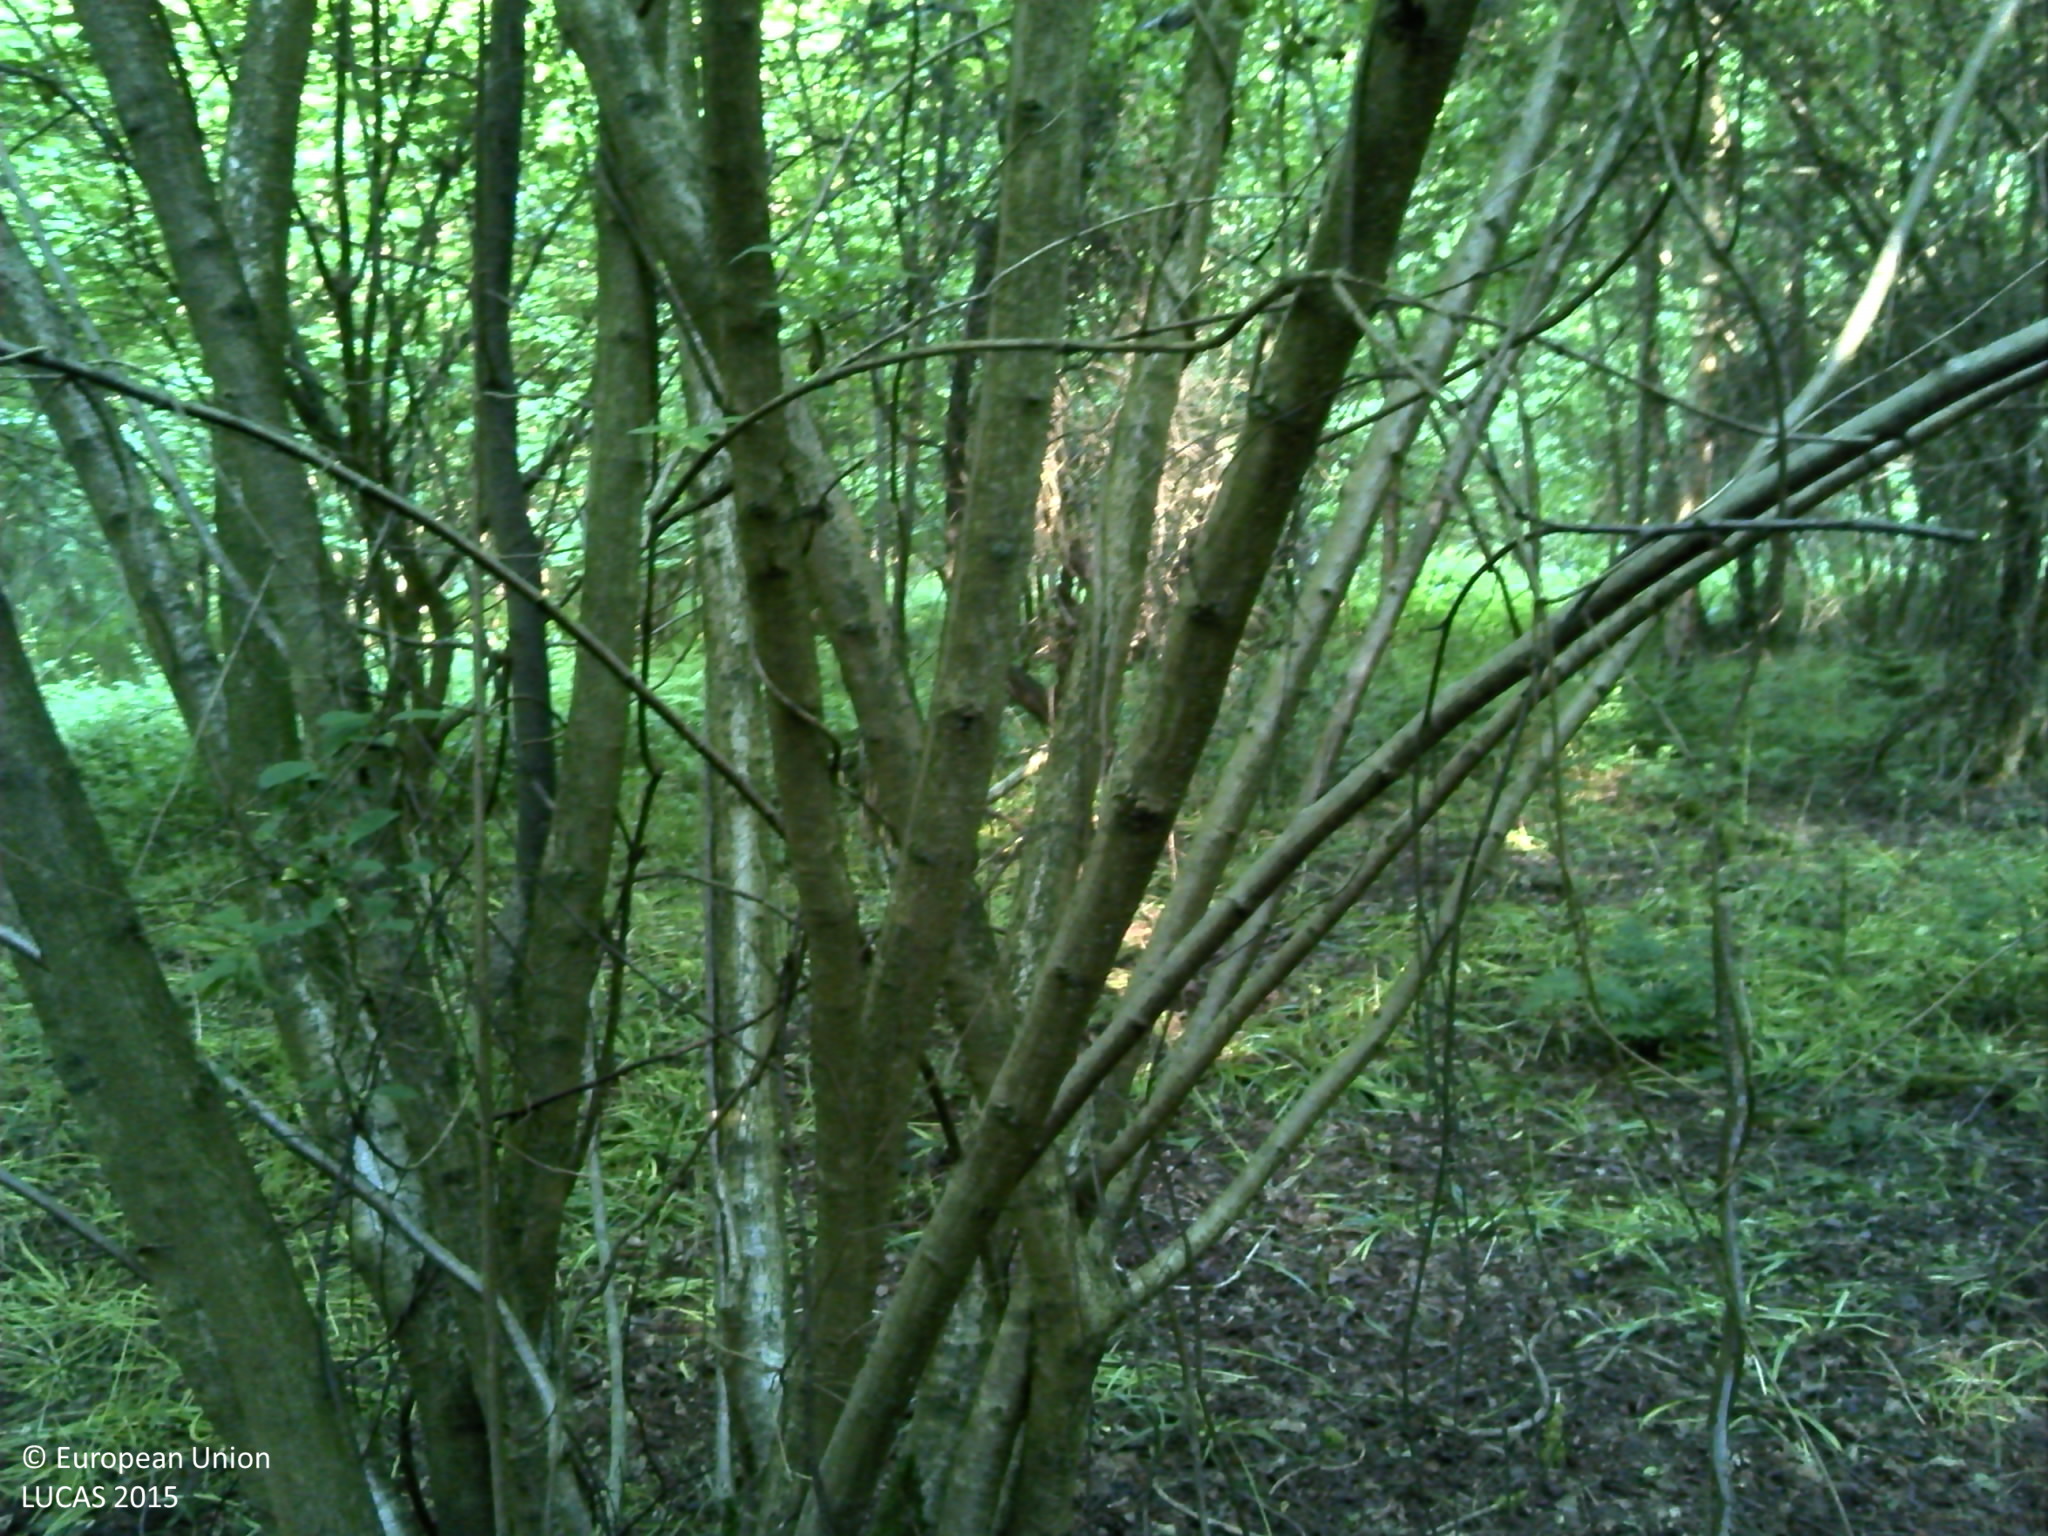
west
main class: Woodland
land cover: Broadleaved woodland
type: mesophytic deciduous forest
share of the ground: > 75 %
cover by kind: broadleaved forest trees 80 %, herbaceous plants 20 %
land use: Forestry
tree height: > 5 m
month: June
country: FR
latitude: 49.6946
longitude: 1.1478
